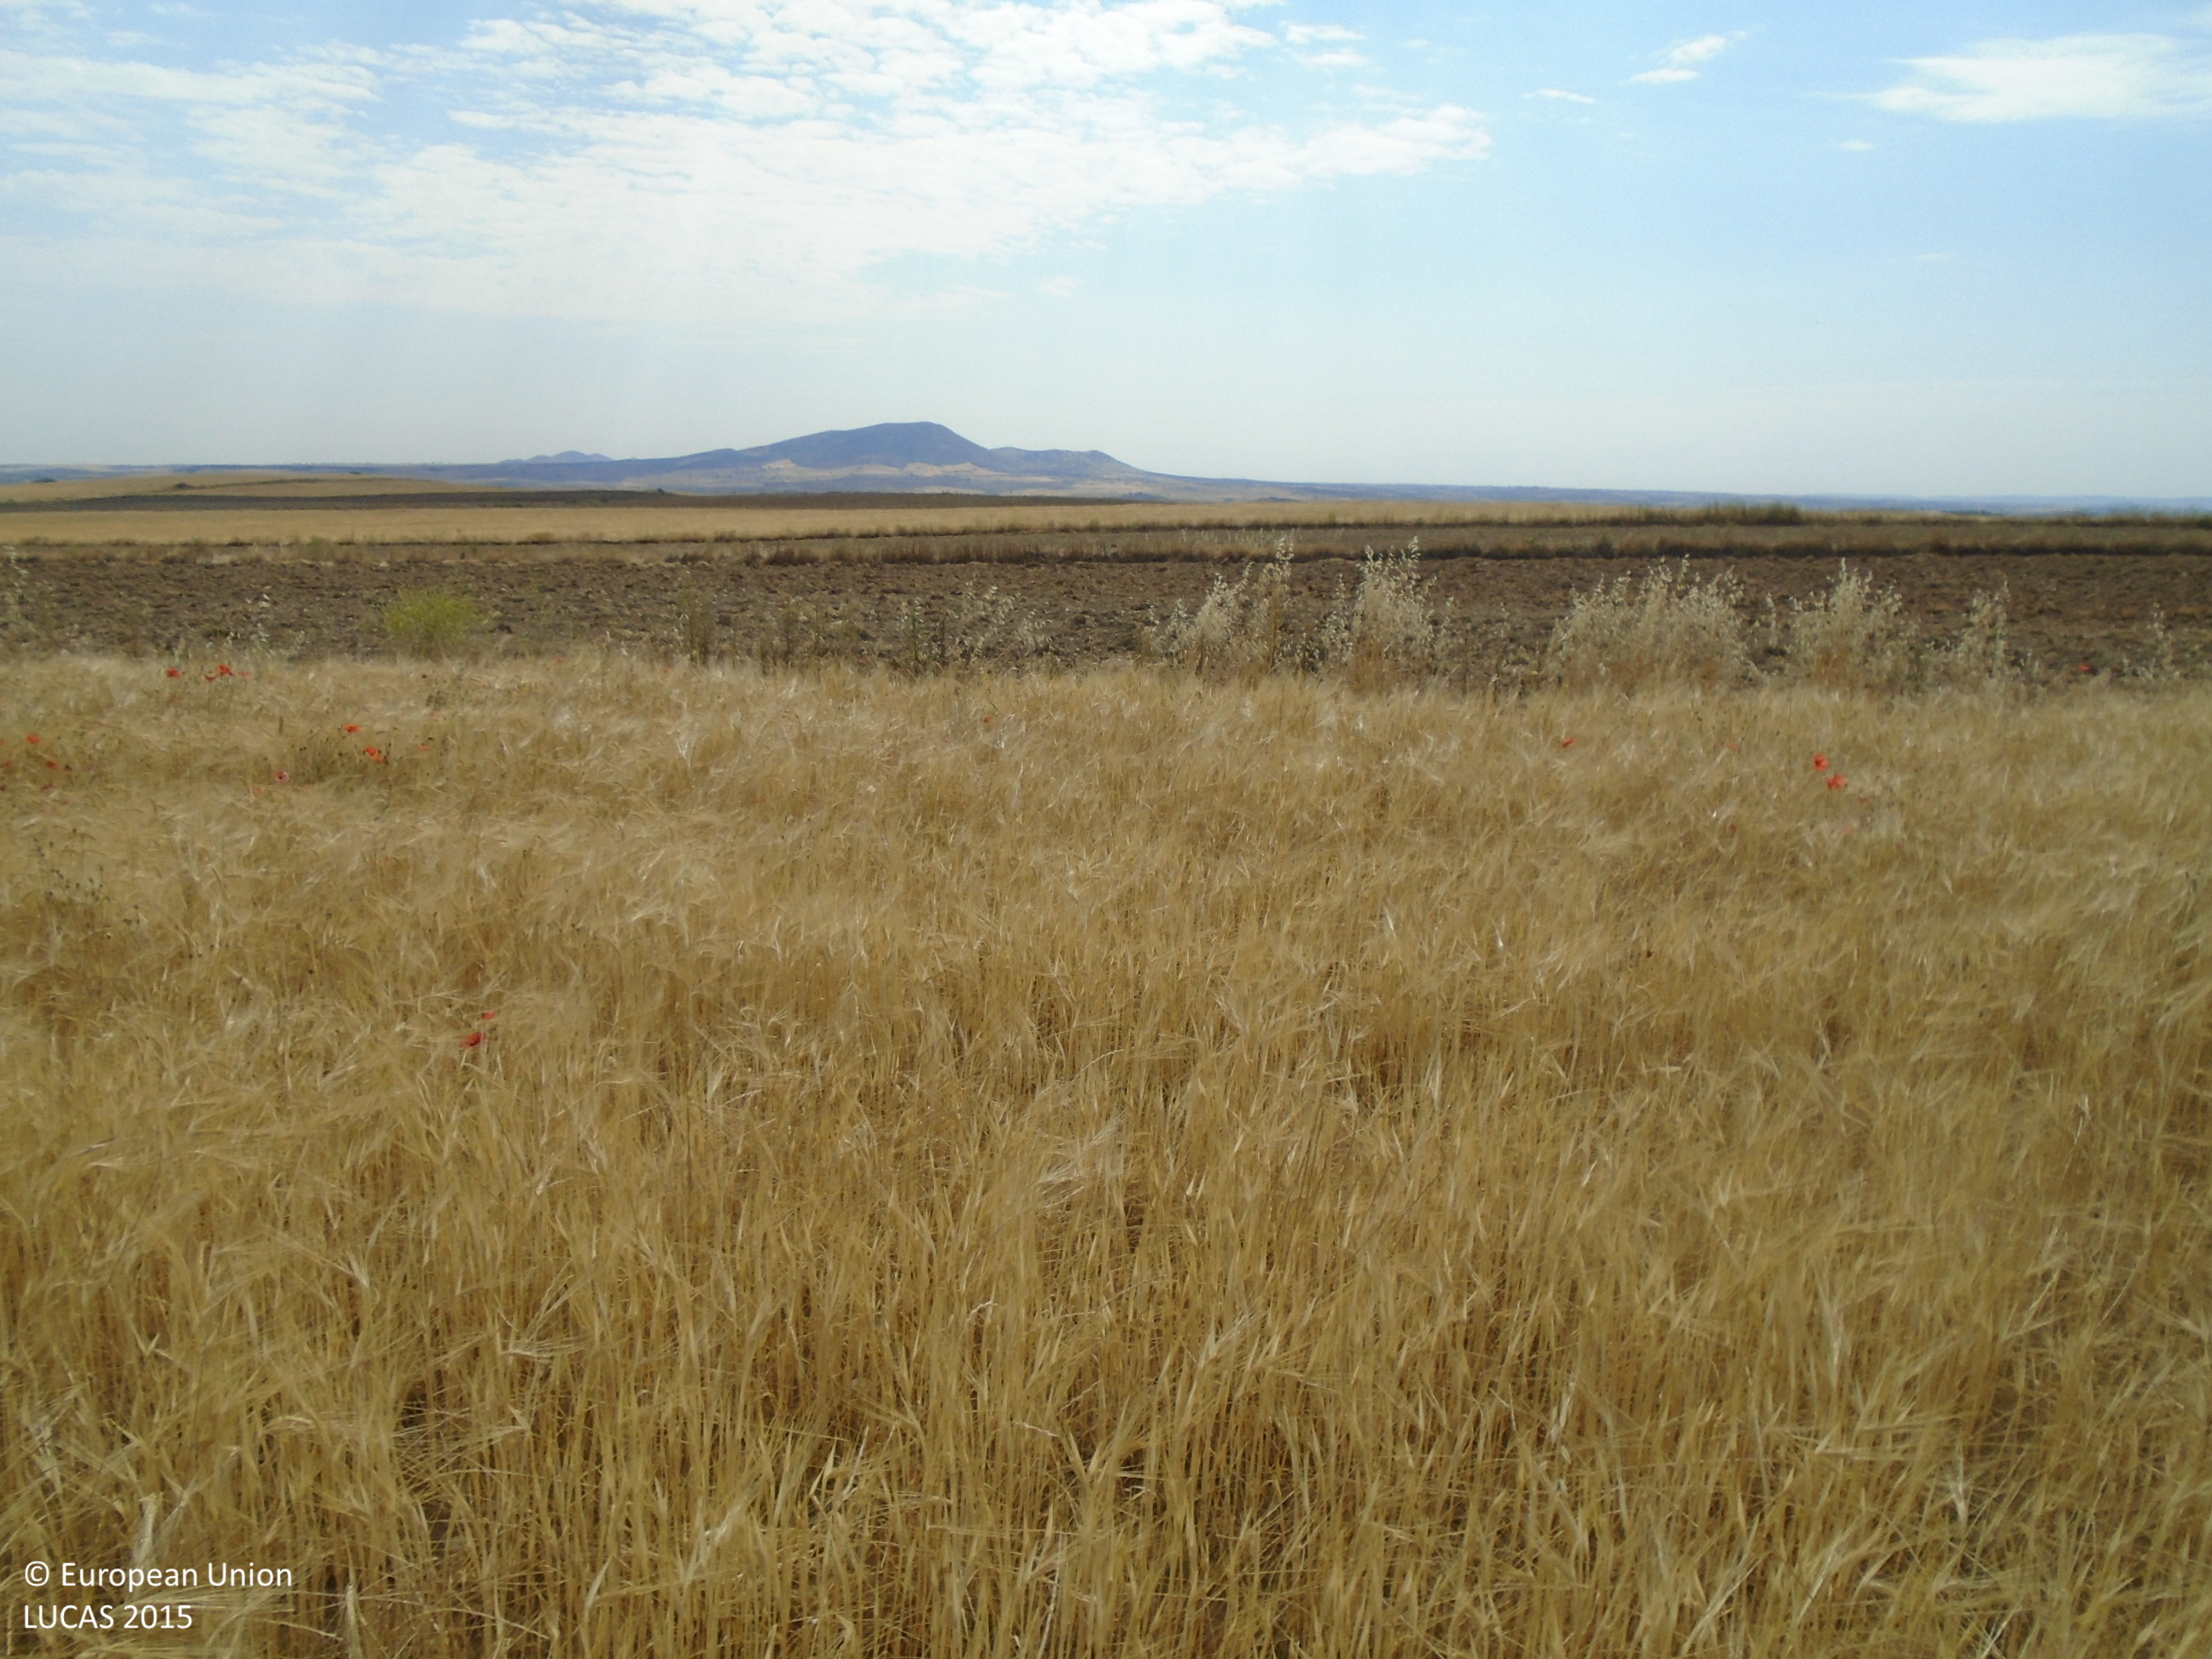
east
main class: Cropland
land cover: Barley
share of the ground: > 75 %
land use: Agriculture (excluding fallow land and kitchen gardens)
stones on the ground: < 10 %
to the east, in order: Barley; Grass margins; Other bare soil; Grass margins; Other bare soil; Grass margins; Barley
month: June
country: ES
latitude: 39.7292
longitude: -4.1636
